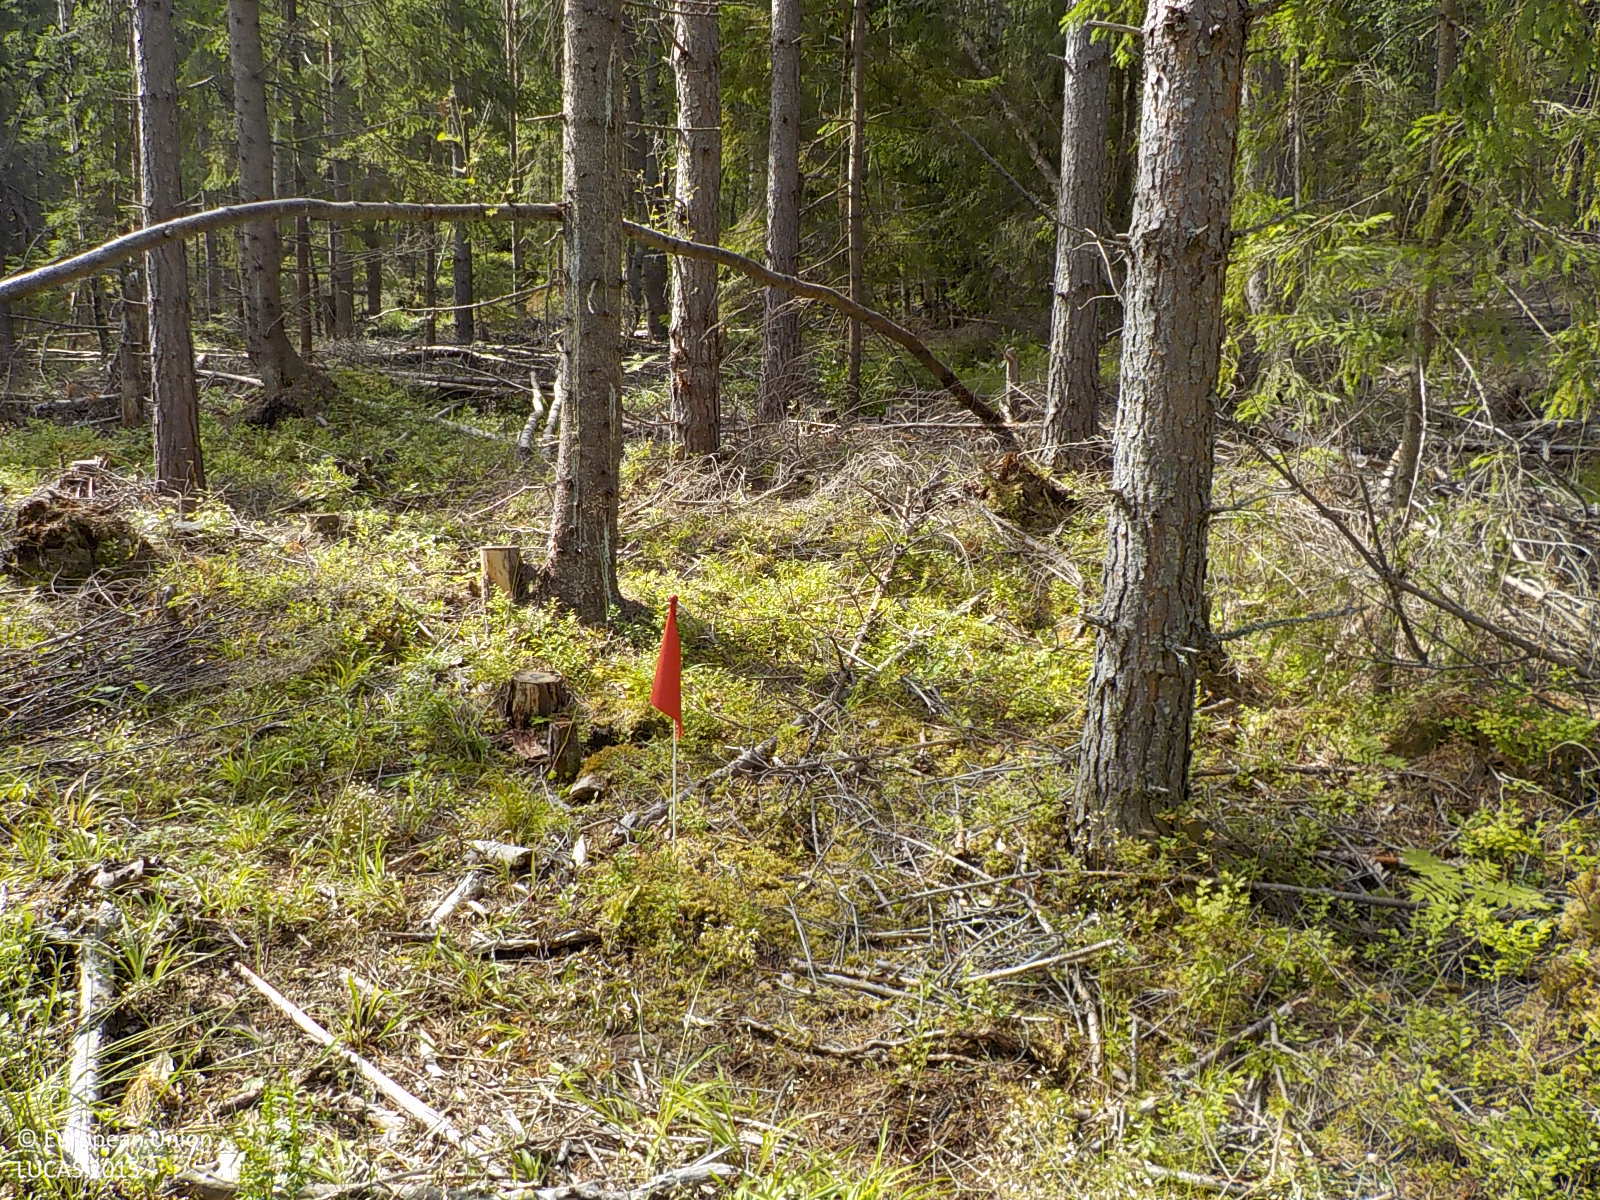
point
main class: Woodland
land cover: Pine dominated coniferous woodland
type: boreal forest
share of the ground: 50 - 75 %
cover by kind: coniferous forest trees 70 %, herbaceous plants 10 %, broadleaved forest trees 5 %, shrubs 5 %
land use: Forestry
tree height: > 5 m
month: July
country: SE
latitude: 63.1940
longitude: 17.3496
